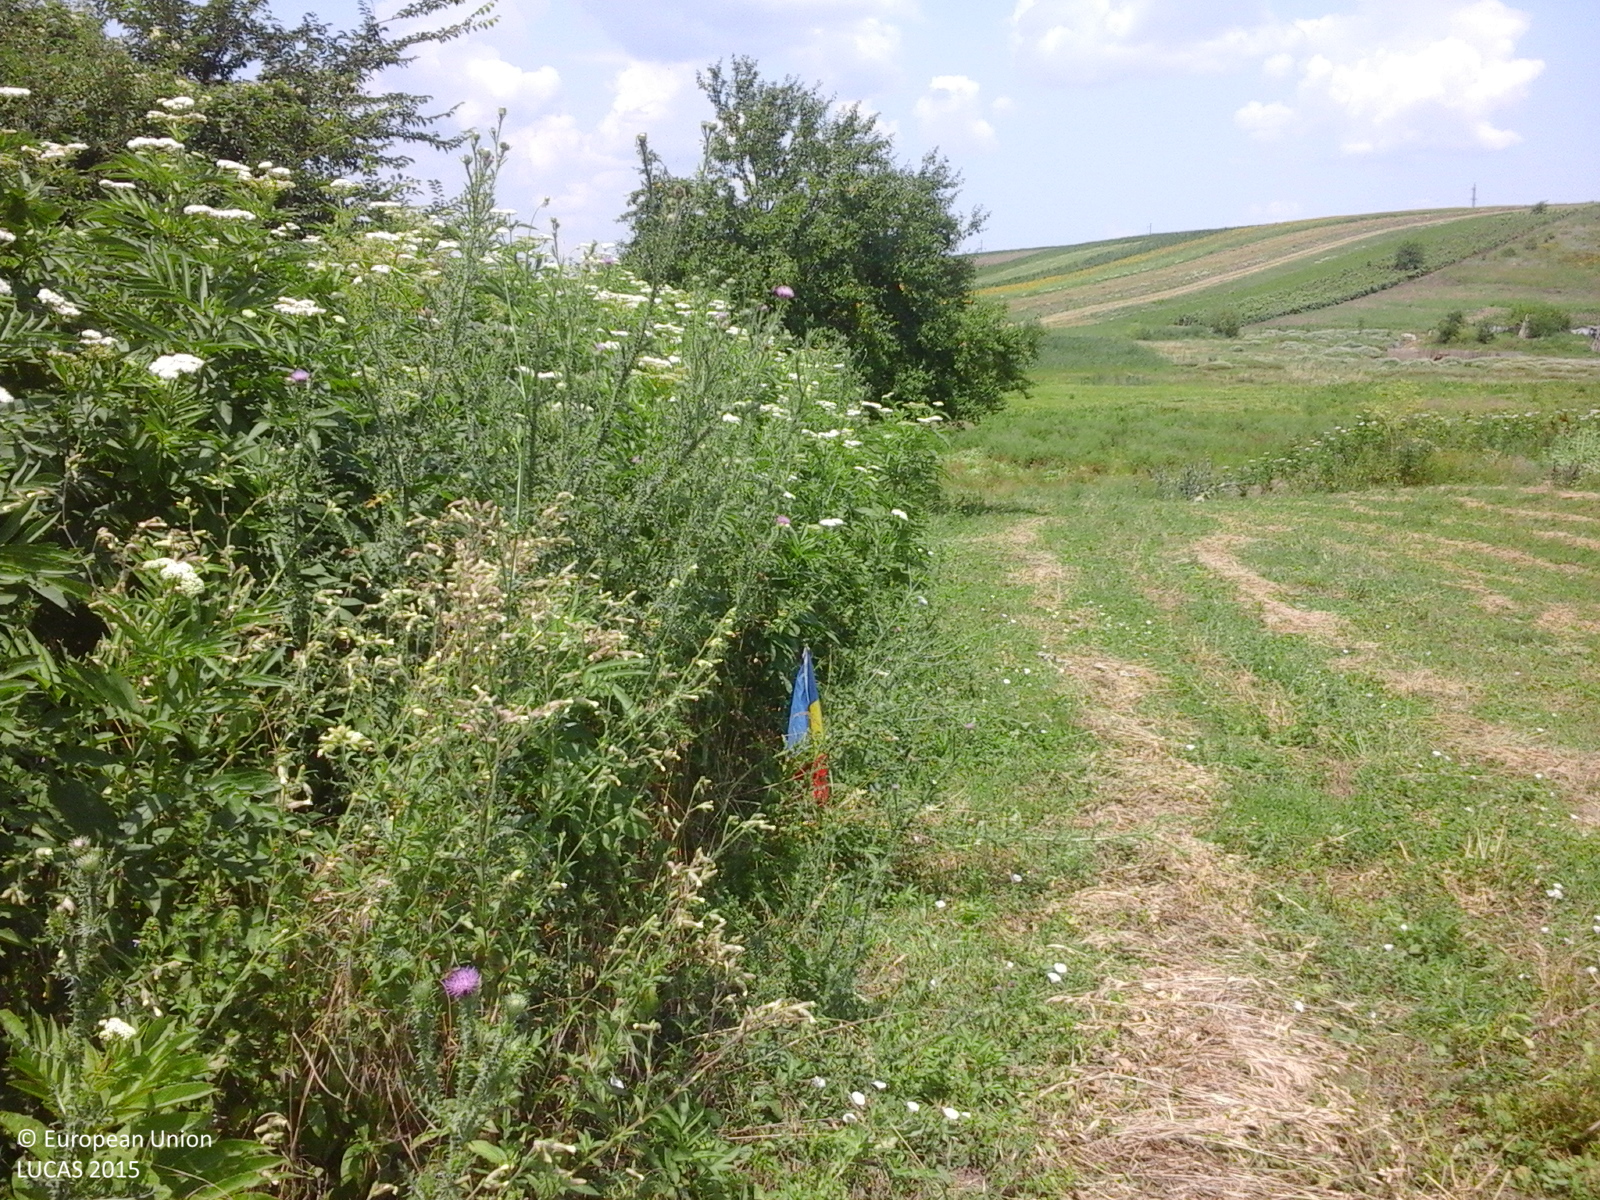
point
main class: Cropland
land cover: Lucerne
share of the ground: > 75 %
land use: Agriculture (excluding fallow land and kitchen gardens)
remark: Harvested field
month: July
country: RO
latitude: 44.1438
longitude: 26.4752
